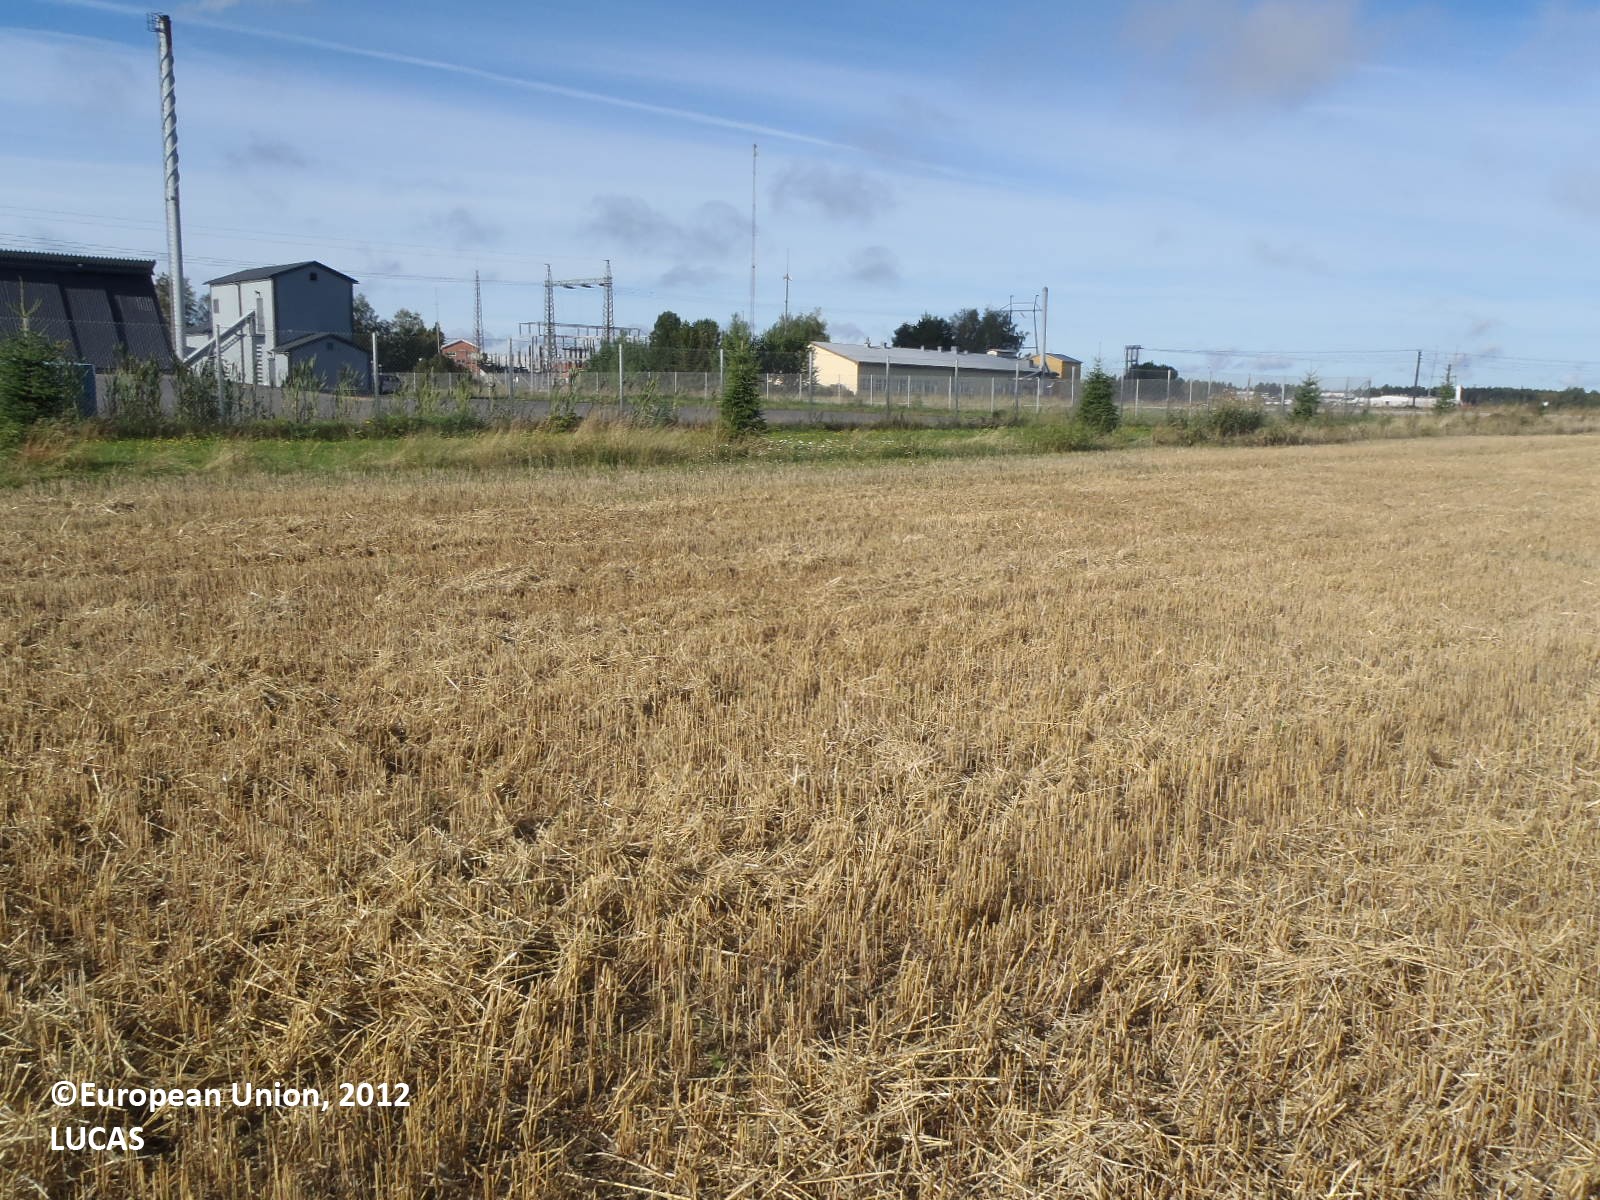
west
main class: Cropland
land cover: Barley
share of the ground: > 75 %
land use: Agriculture (excluding fallow land and kitchen gardens)
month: September
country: FI
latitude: 61.0600
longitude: 22.3469
